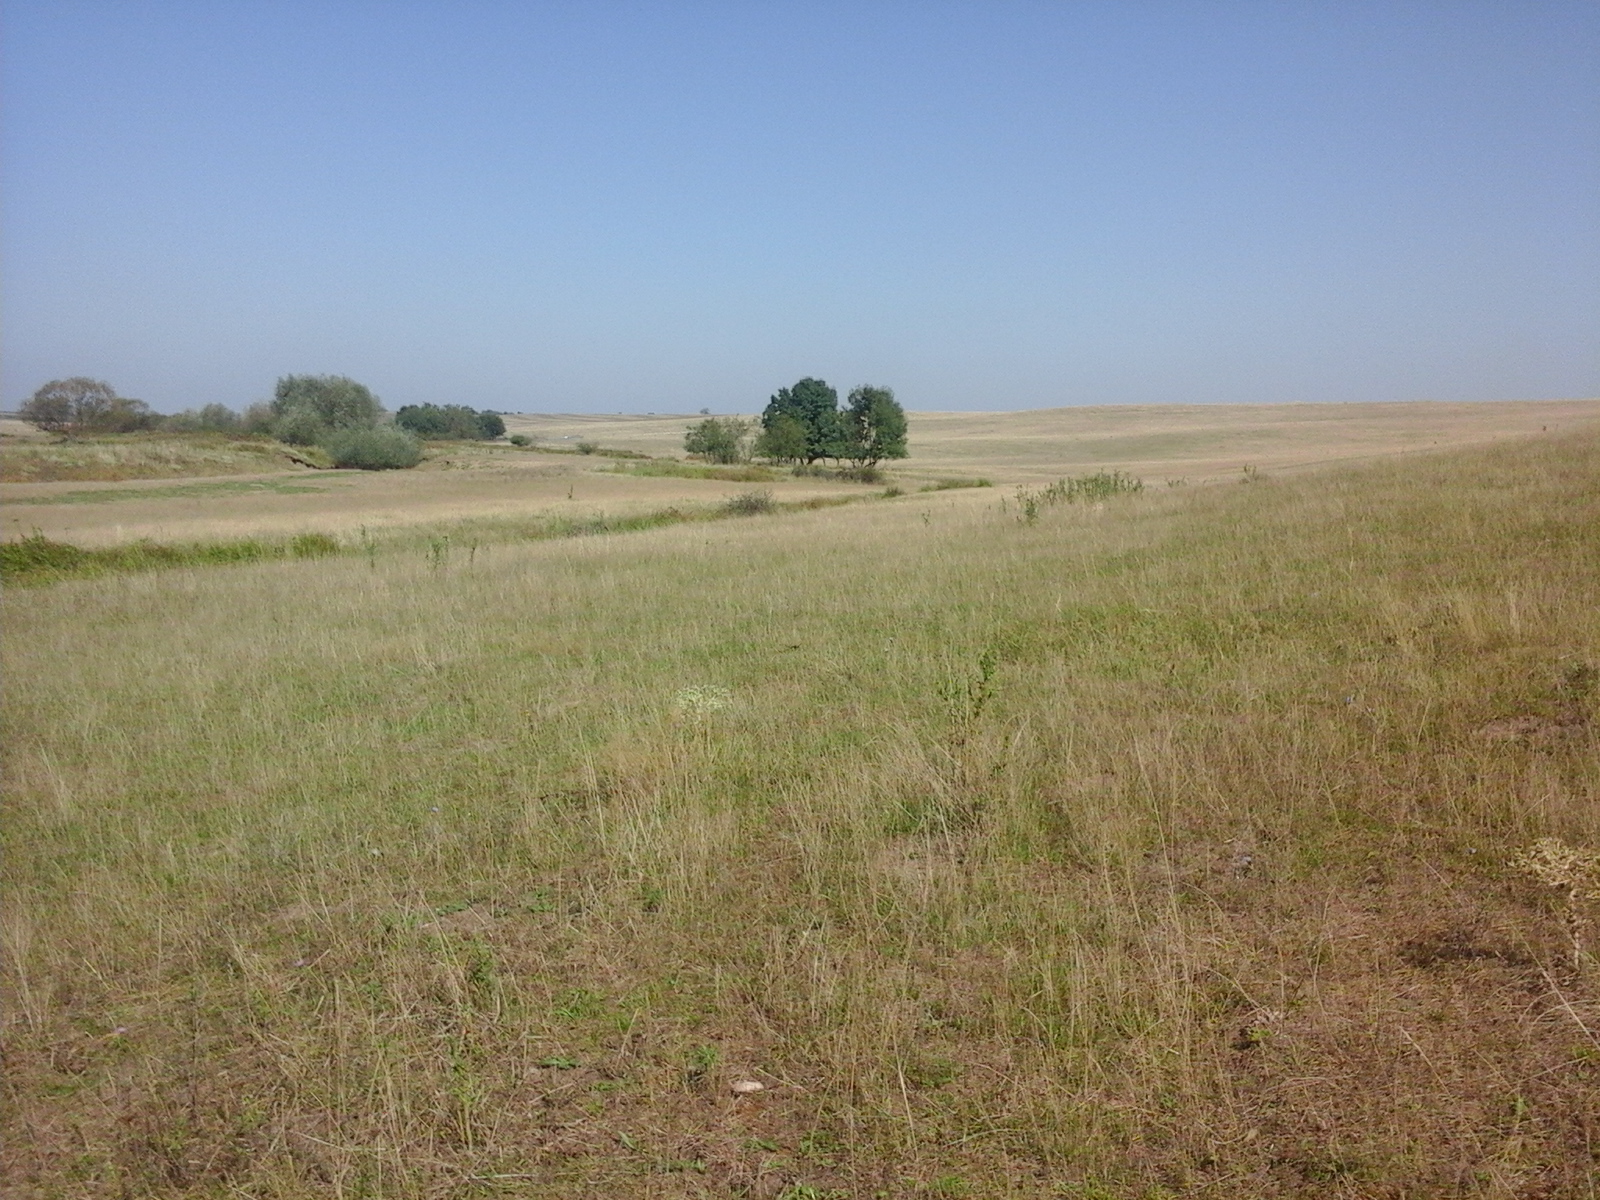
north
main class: Grassland
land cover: Grassland without tree/shrub cover
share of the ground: > 75 %
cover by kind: herbaceous plants 100 %
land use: Agriculture (excluding fallow land and kitchen gardens)
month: August
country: RO
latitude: 45.6464
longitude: 21.7509
